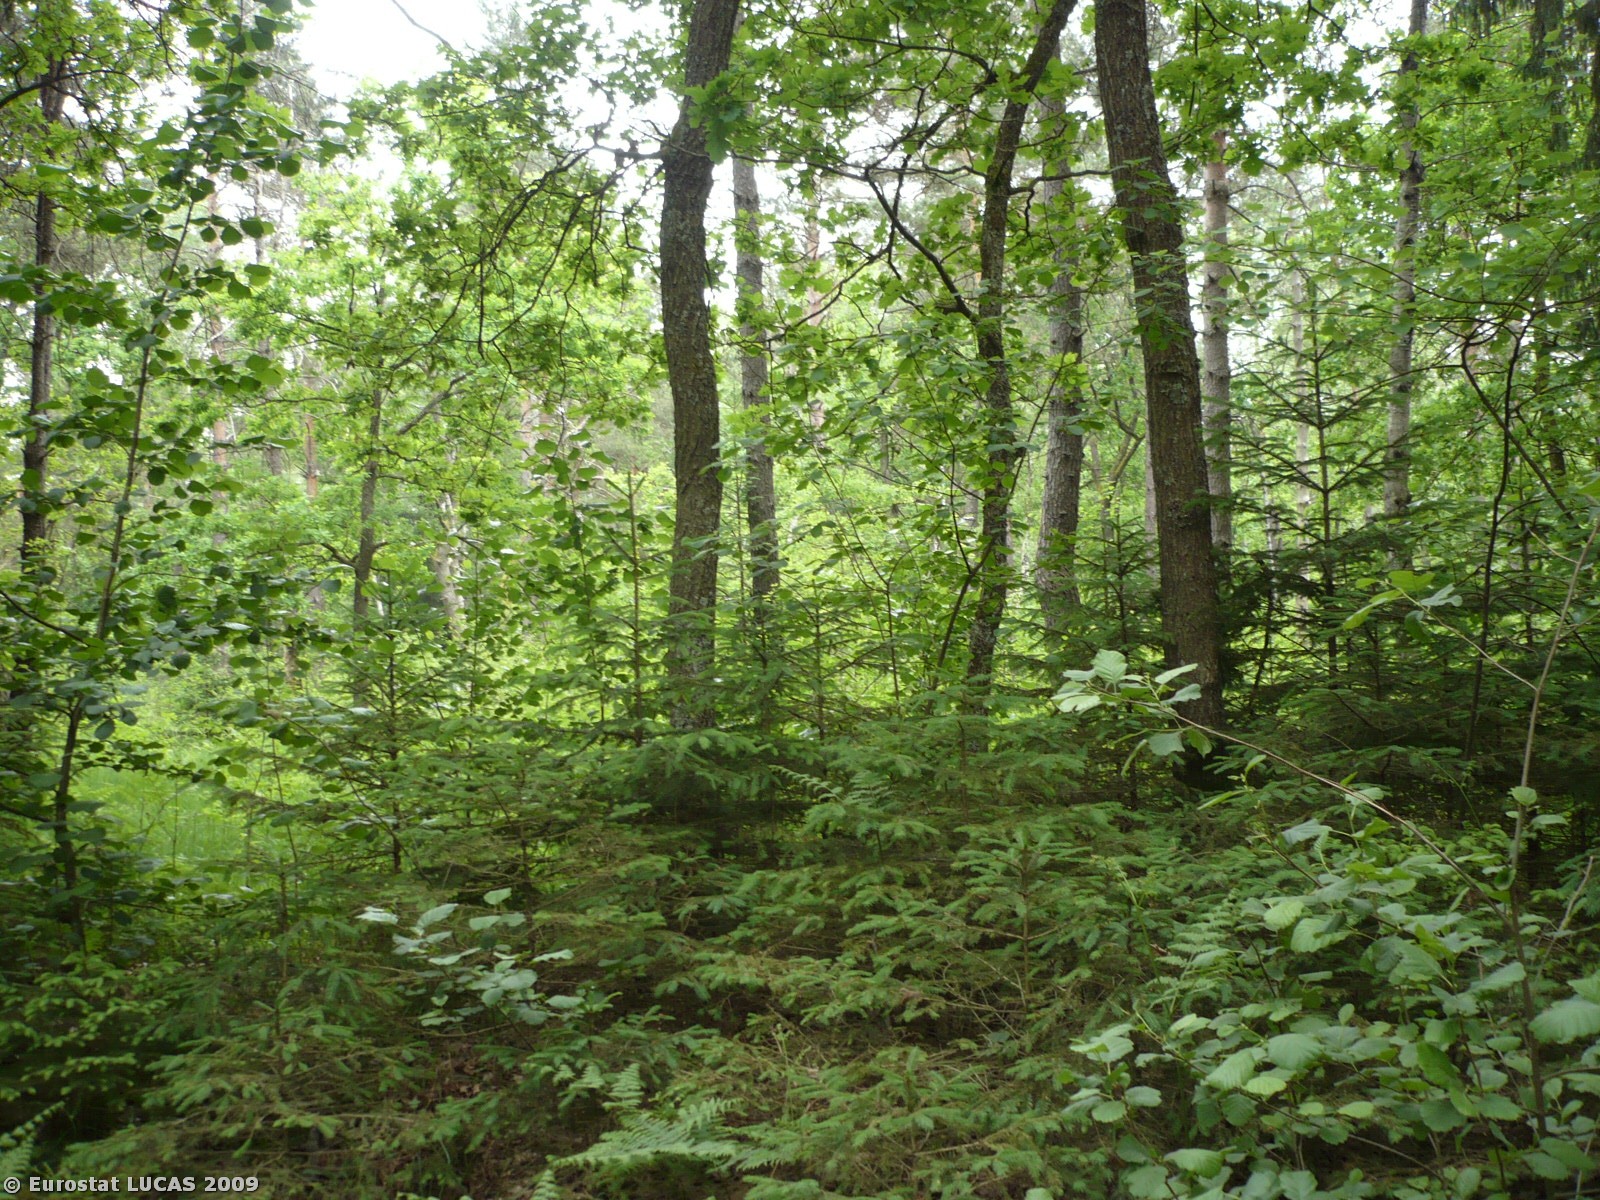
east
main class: Woodland
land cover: Mixed woodland
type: hemiboreal forest and nemoral coniferous forest and mixed broadleaved-coniferous forest
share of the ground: > 75 %
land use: Forestry
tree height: > 5 m
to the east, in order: Mixed woodland; Tracks; Mixed woodland; Tracks; Mixed woodland; Tracks; Coniferous woodland; Mixed woodland; Tracks; Grassland with sparse tree/shrub cover
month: May
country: SI
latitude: 46.1721
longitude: 14.3617
